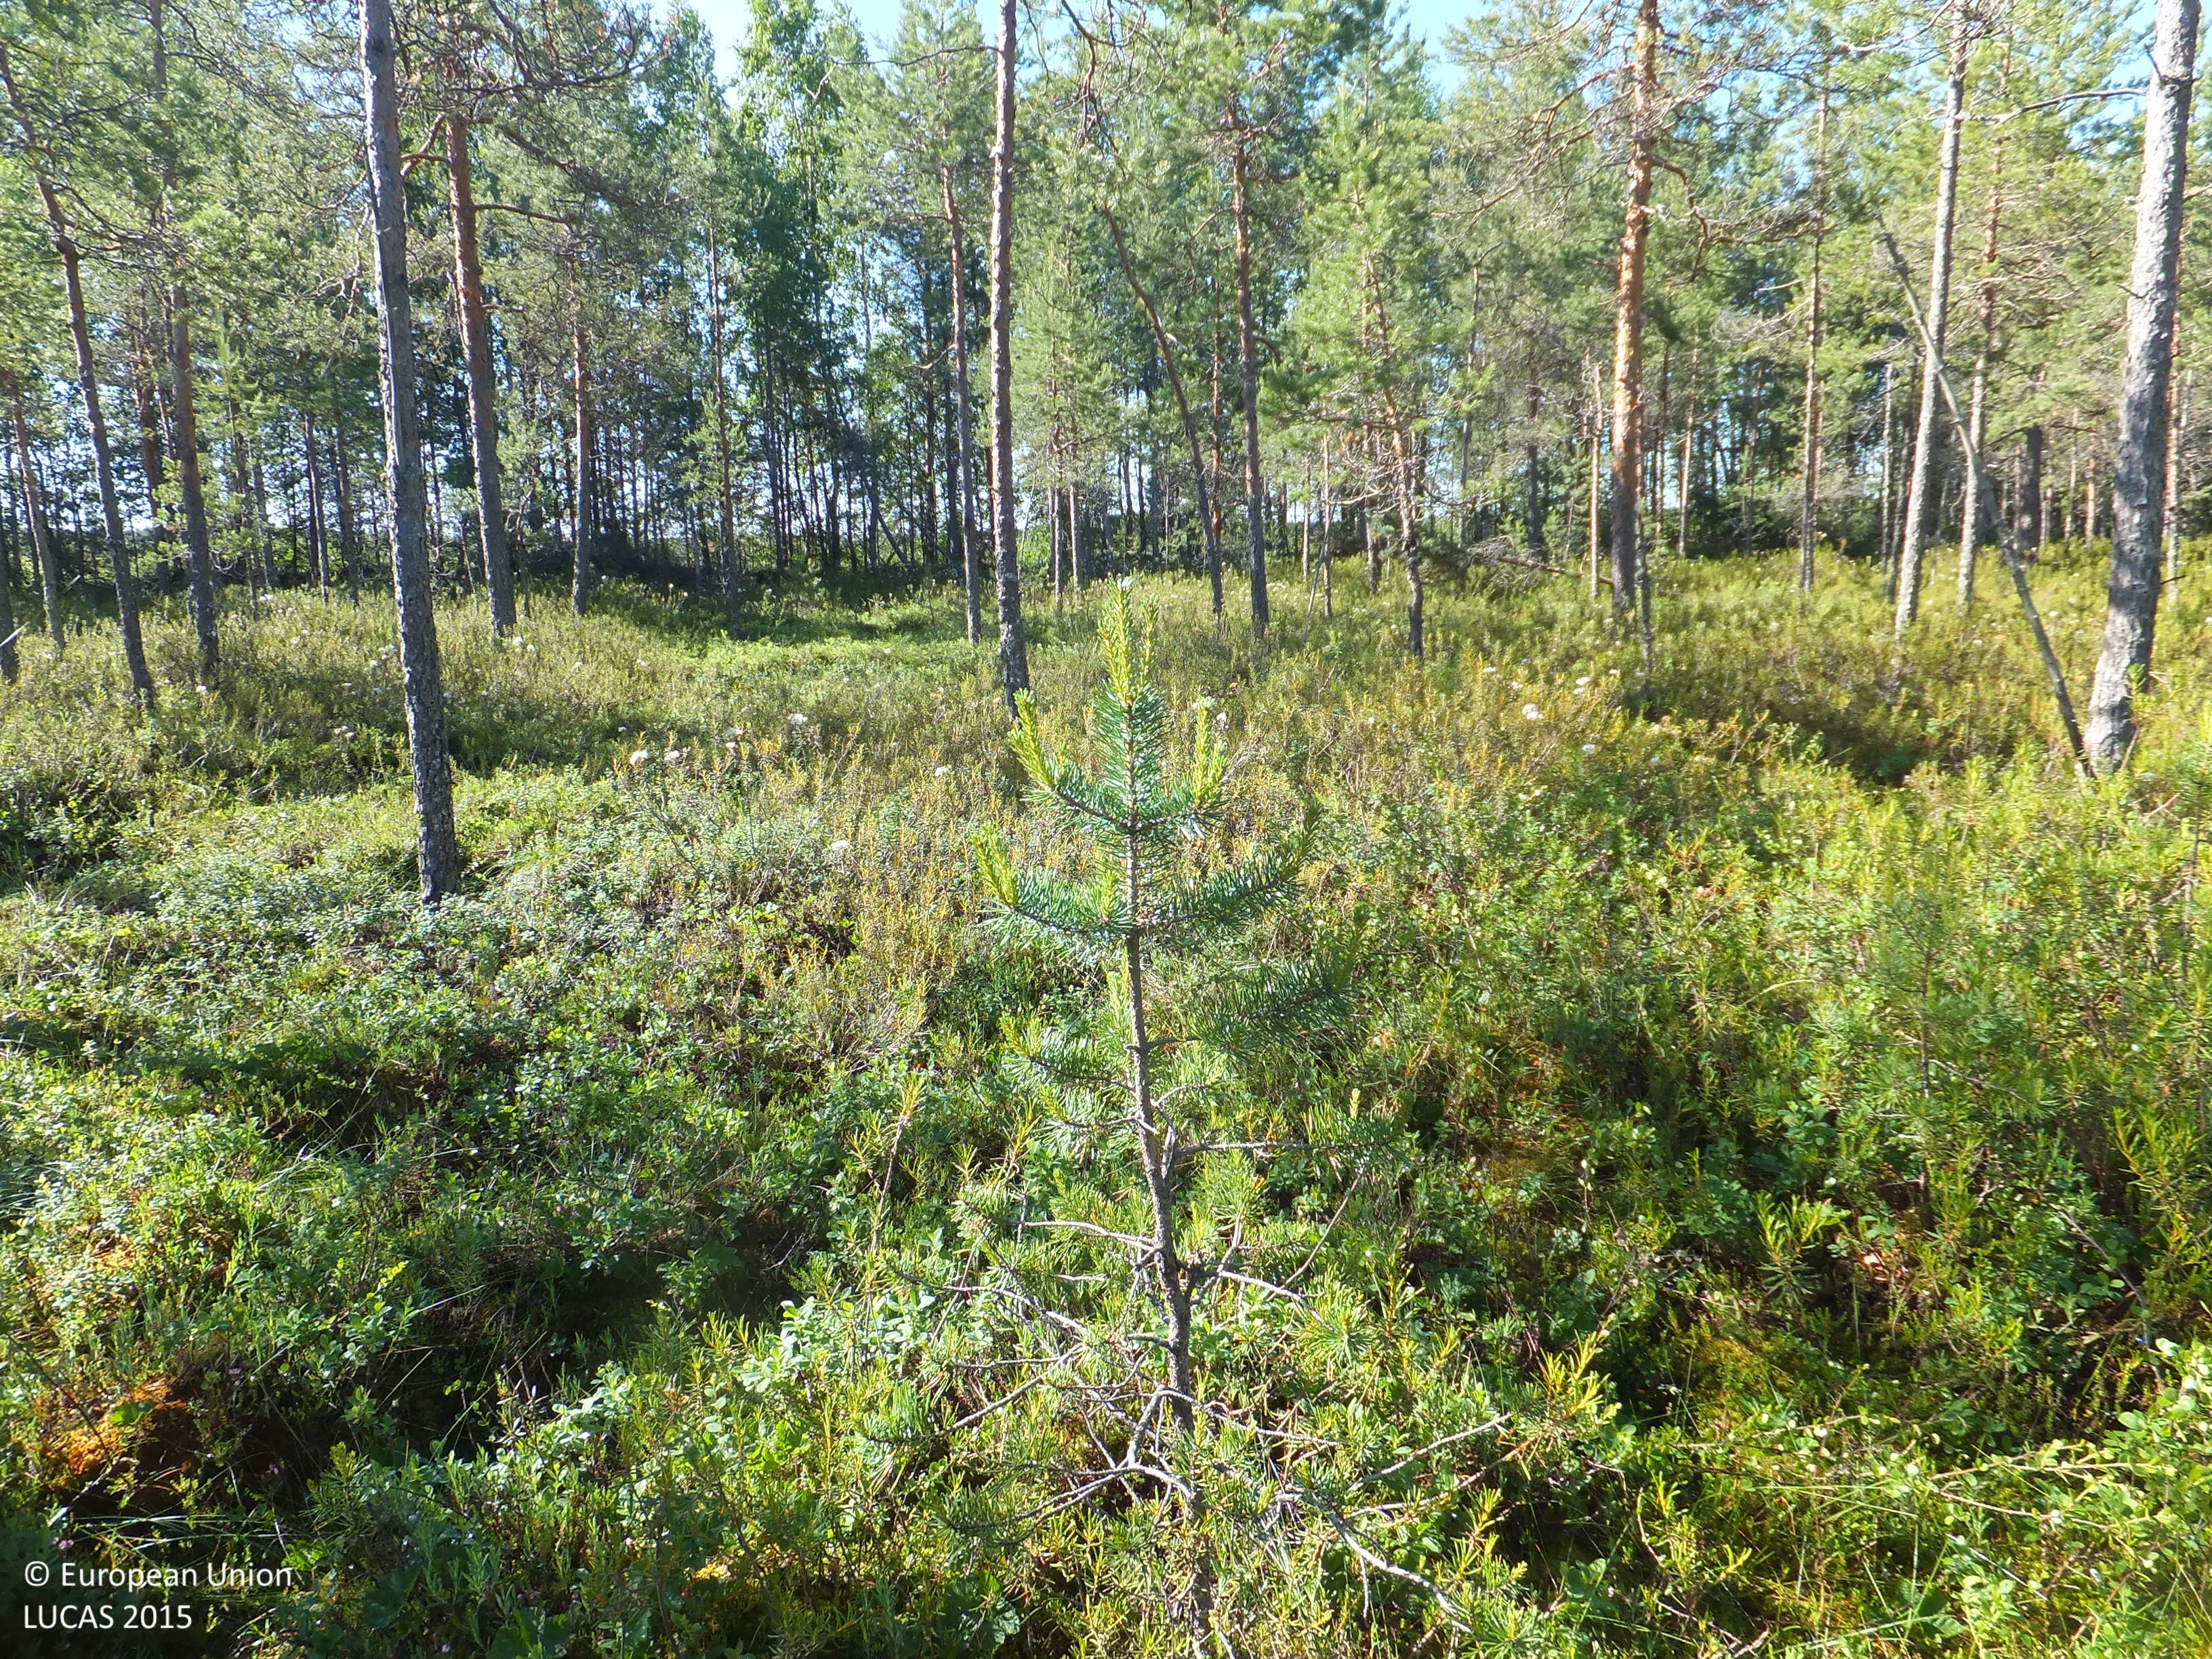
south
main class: Woodland
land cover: Pine dominated coniferous woodland
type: mire and swamp forests
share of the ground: 50 - 75 %
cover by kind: coniferous forest trees 50 %, shrubs 40 %, lichens and mosses 10 %
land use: Forestry
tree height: > 5 m
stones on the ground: < 10 %
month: July
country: FI
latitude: 63.1708
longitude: 23.9548
